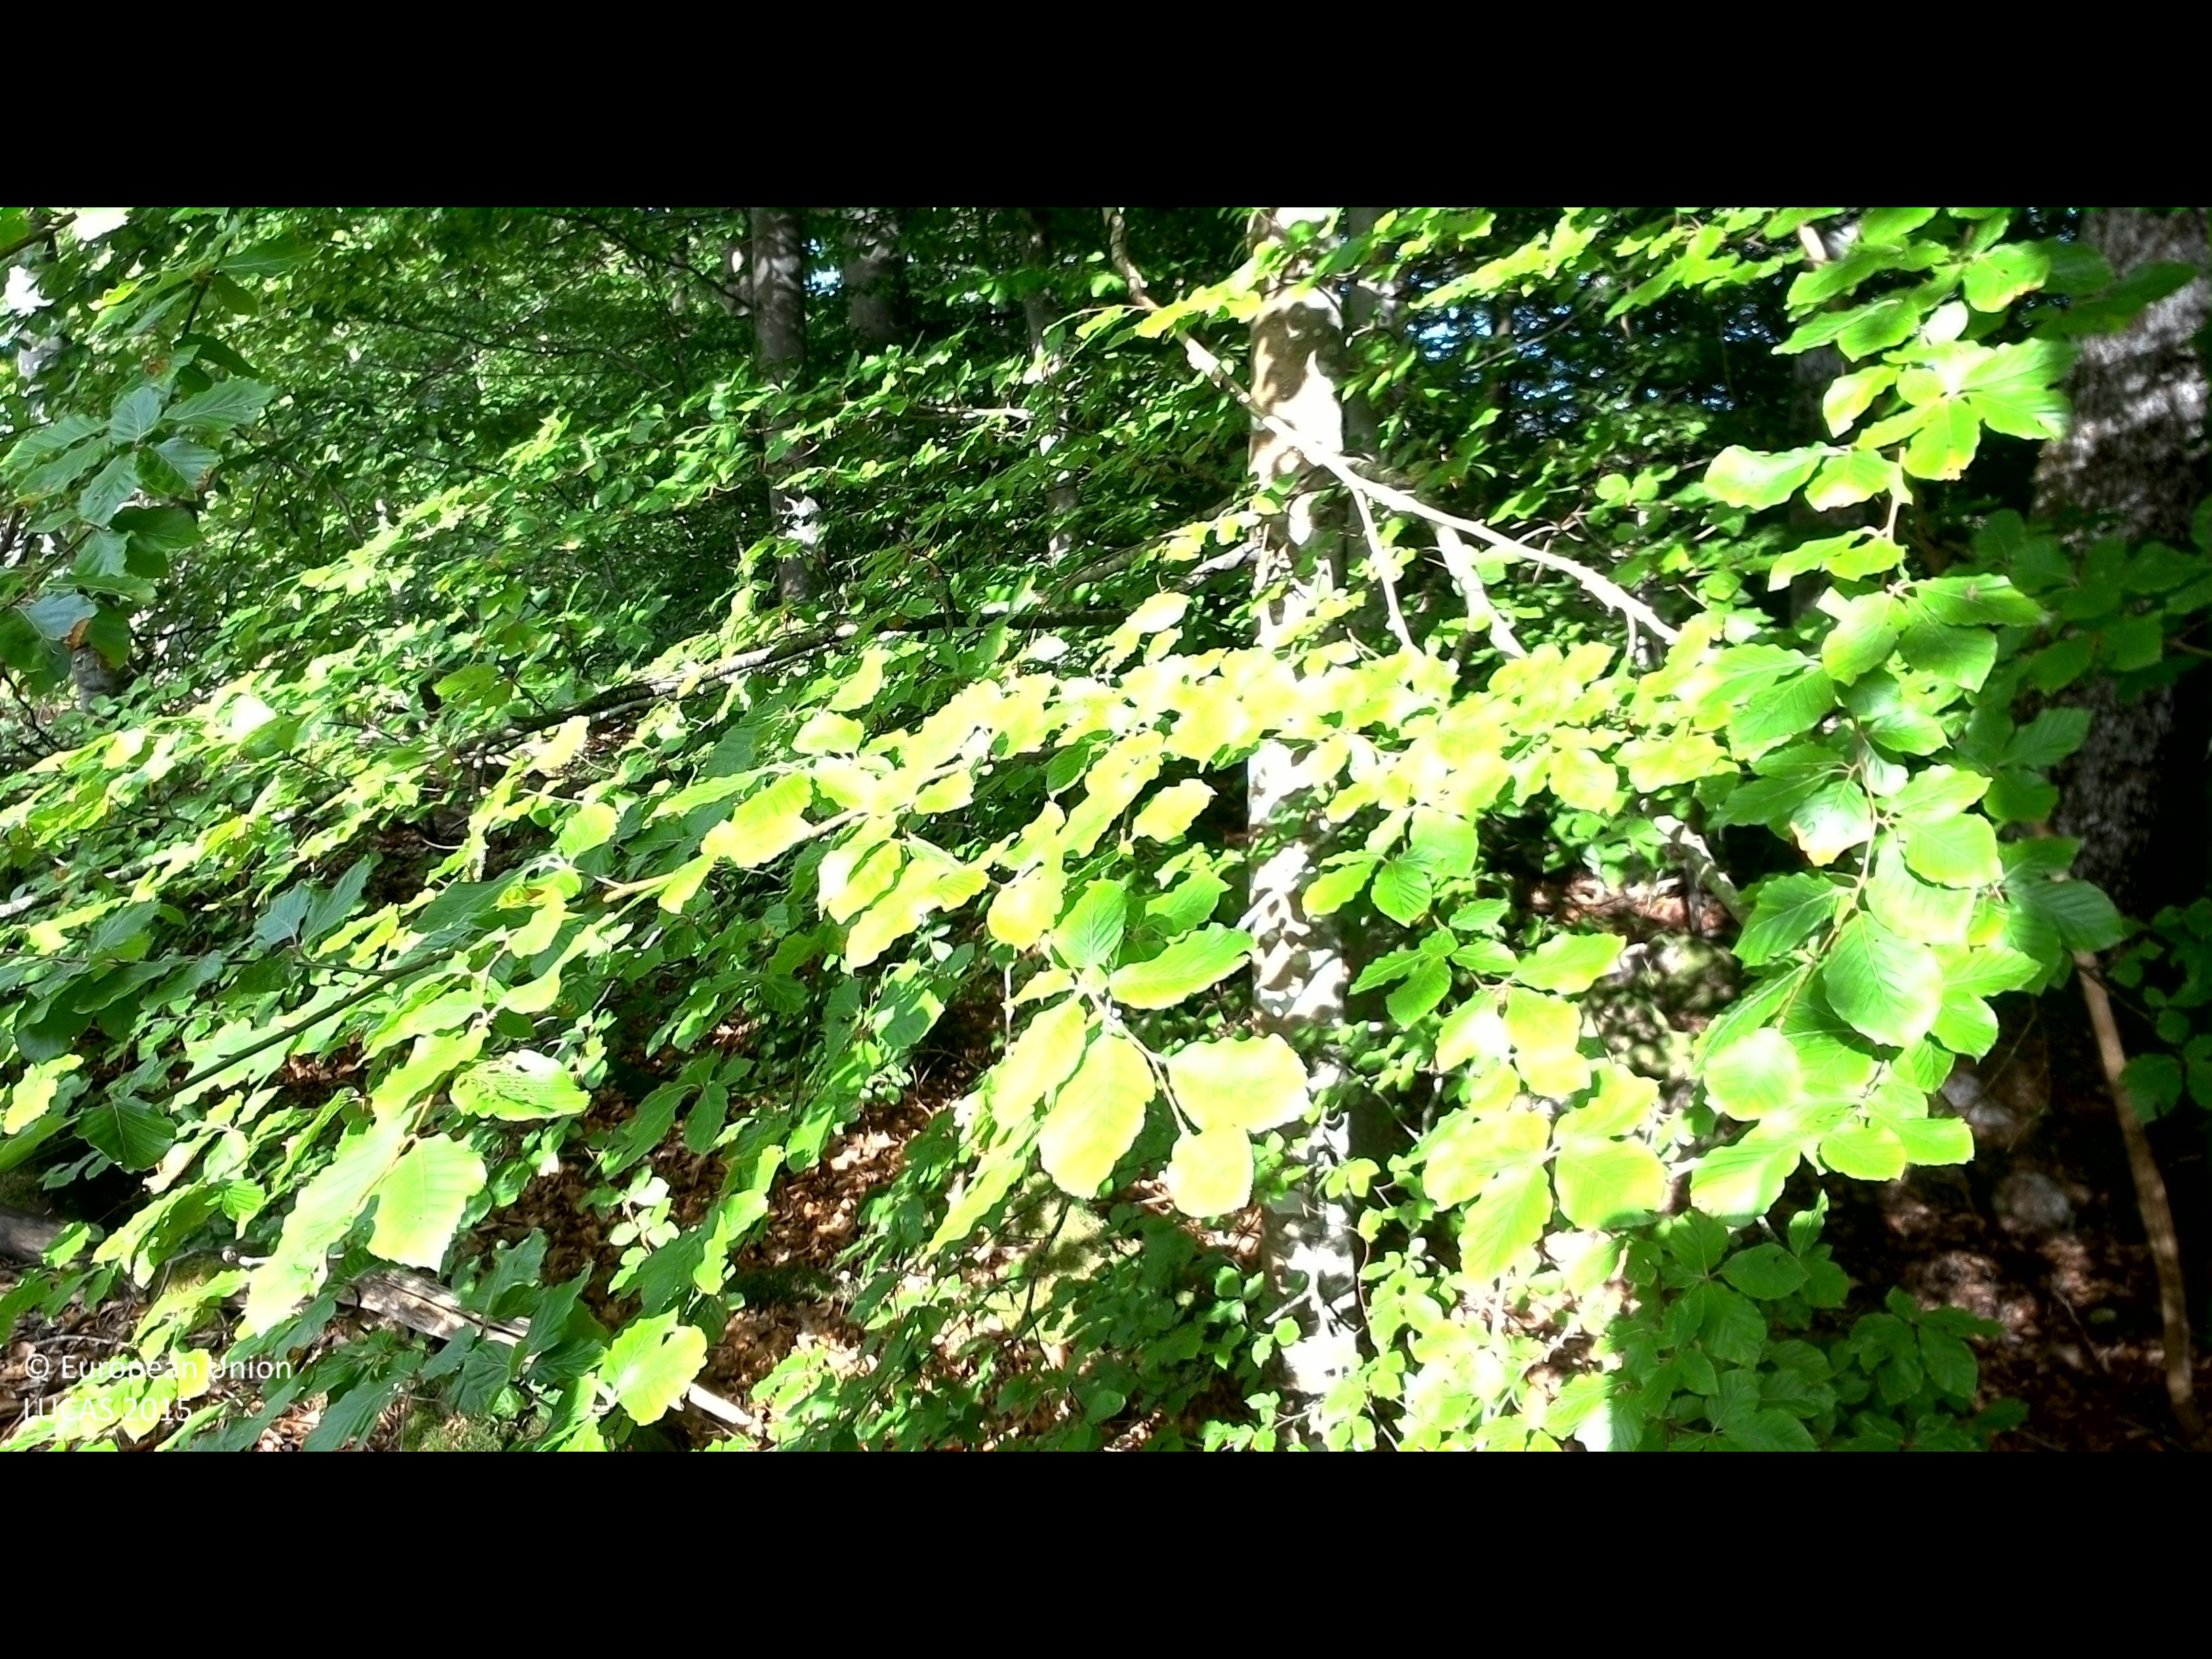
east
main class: Woodland
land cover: Broadleaved woodland
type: beech forest
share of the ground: > 75 %
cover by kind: broadleaved forest trees 90 %, shrubs 5 %, herbaceous plants 5 %
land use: Forestry
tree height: > 5 m
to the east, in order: Broadleaved woodland; Tracks; Broadleaved woodland; Fences; Broadleaved woodland
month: June
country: SE
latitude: 56.3090
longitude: 15.8030
